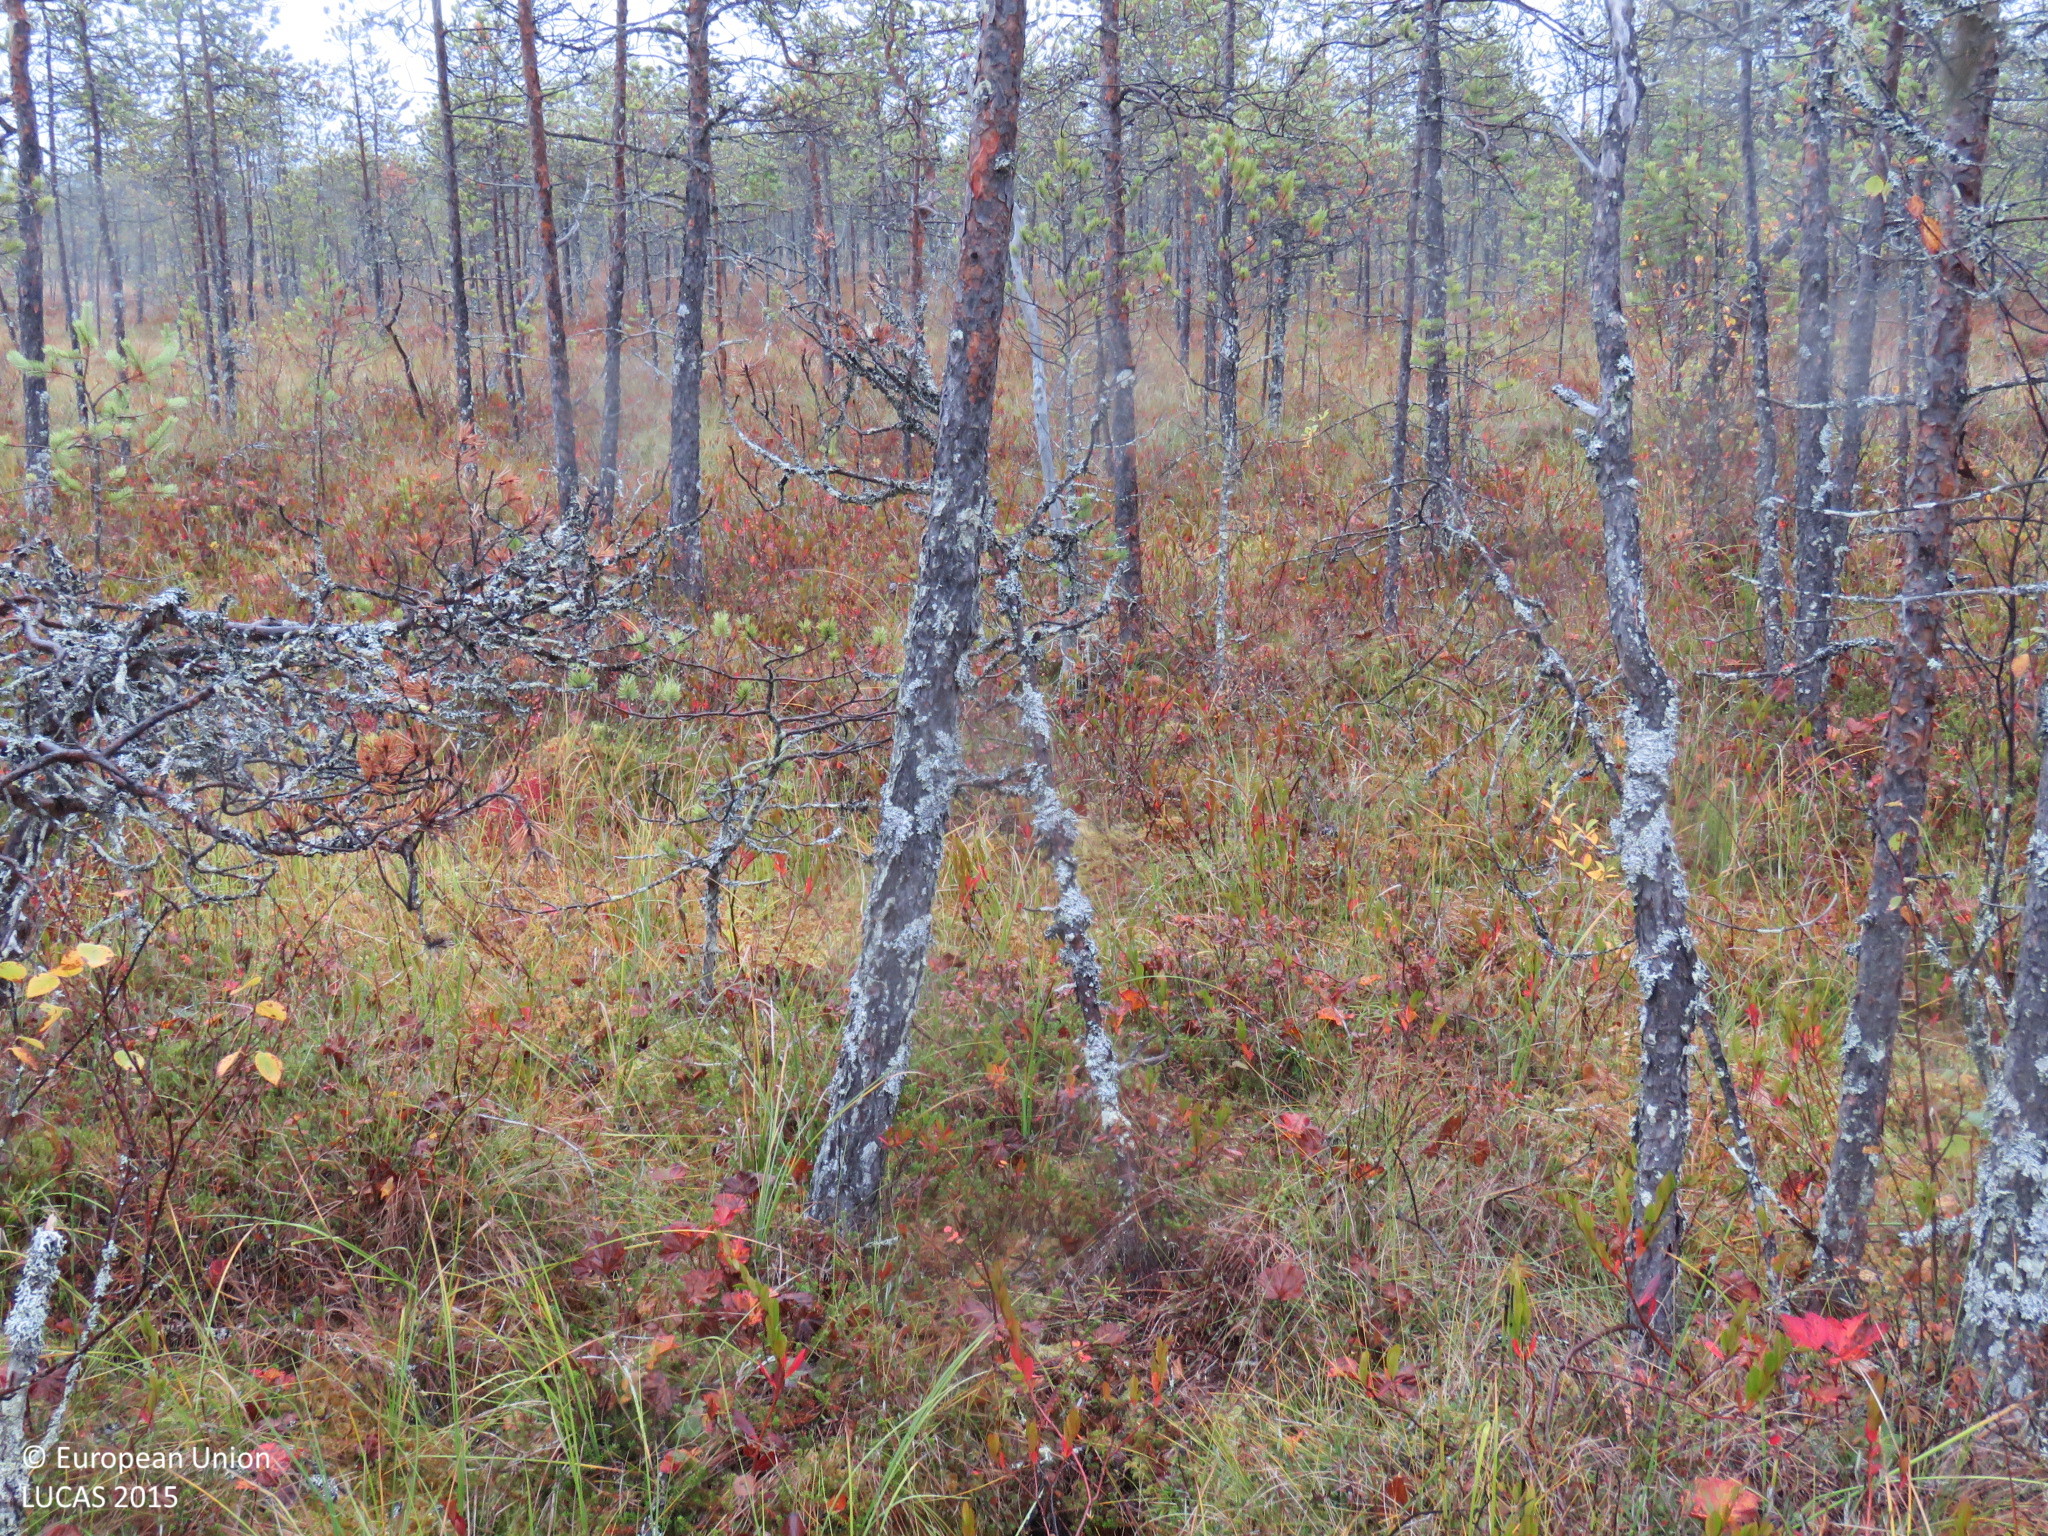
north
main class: Woodland
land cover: Pine dominated coniferous woodland
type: mire and swamp forests
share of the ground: 50 - 75 %
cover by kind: coniferous forest trees 70 %, shrubs 15 %, herbaceous plants 10 %, lichens and mosses 5 %
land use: Semi-natural and natural areas not in use
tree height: < 5 m
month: September
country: FI
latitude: 64.8653
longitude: 26.6351
